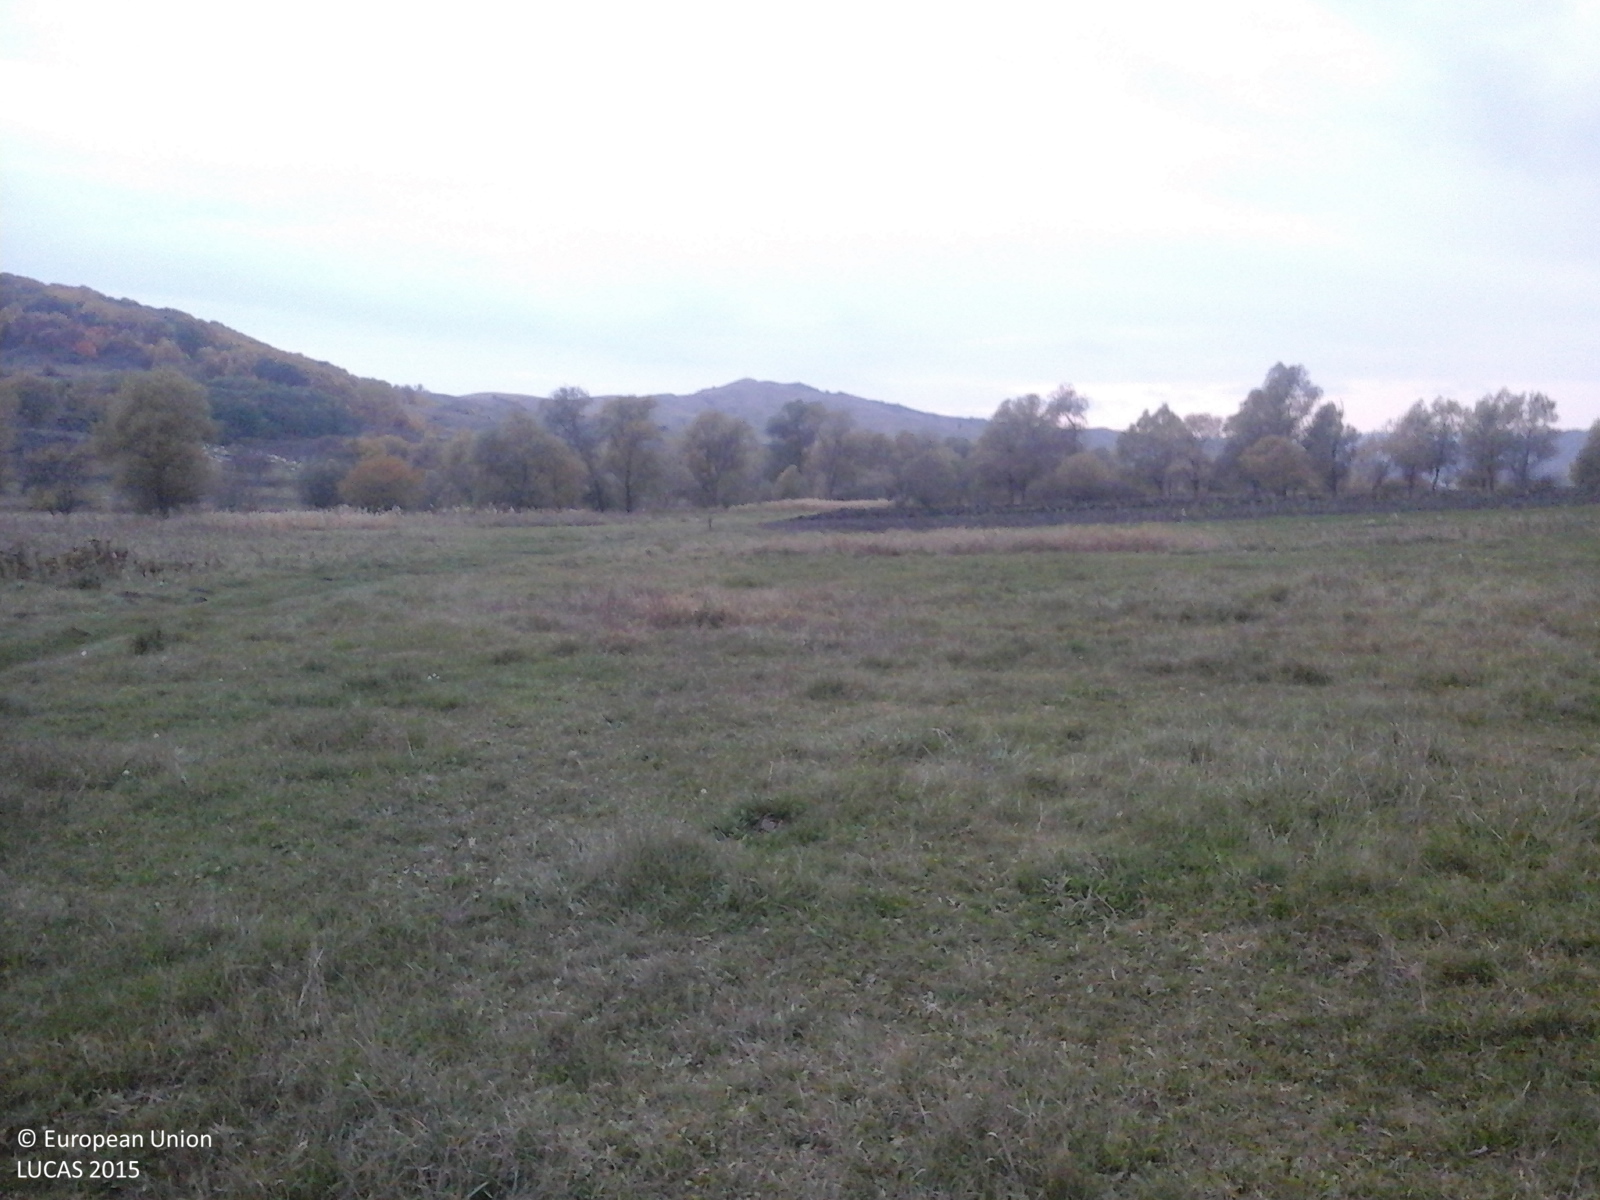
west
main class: Grassland
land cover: Grassland without tree/shrub cover
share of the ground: > 75 %
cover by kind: herbaceous plants 100 %
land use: Agriculture (excluding fallow land and kitchen gardens)
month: October
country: RO
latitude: 45.3958
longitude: 26.8028
